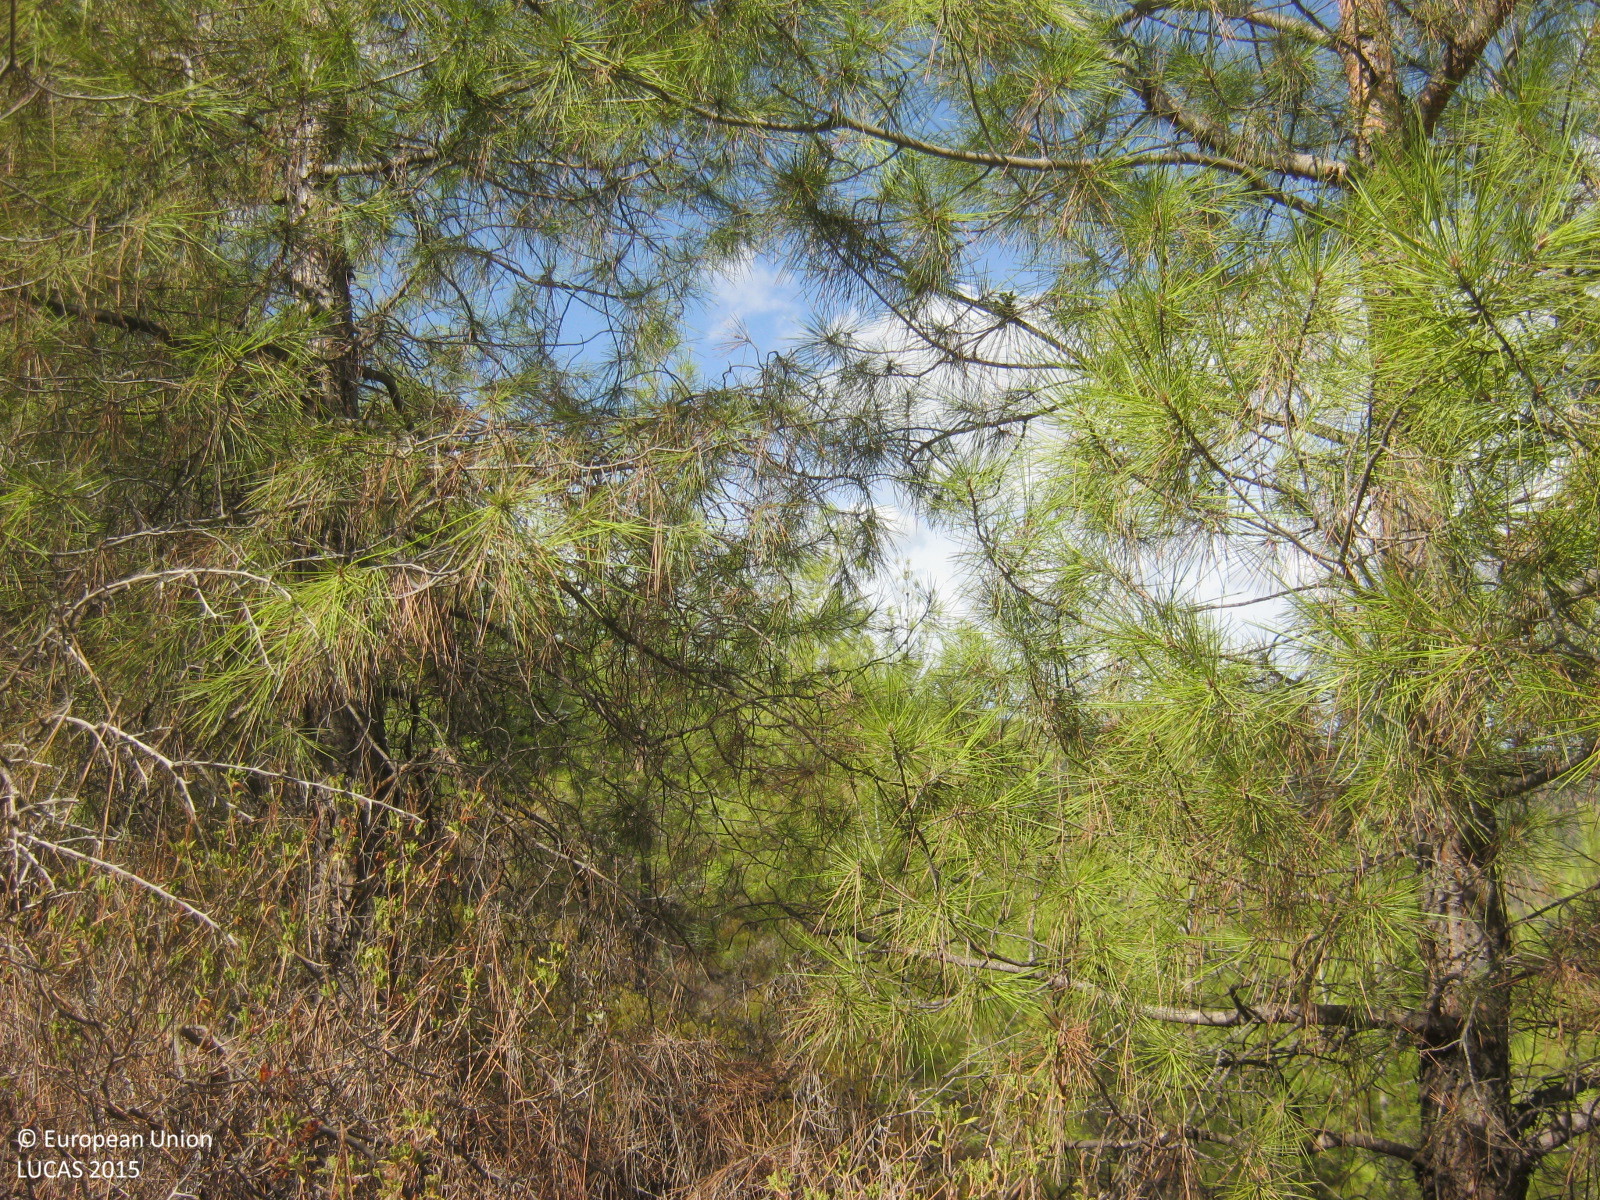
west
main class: Woodland
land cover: Pine dominated coniferous woodland
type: coniferous forest of the mediterranean region
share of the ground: > 75 %
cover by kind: coniferous forest trees 75 %, shrubs 15 %, herbaceous plants 5 %, unconsolidated bare surface 5 %
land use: Forestry
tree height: > 5 m
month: September
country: CY
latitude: 35.0492
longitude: 32.8073
